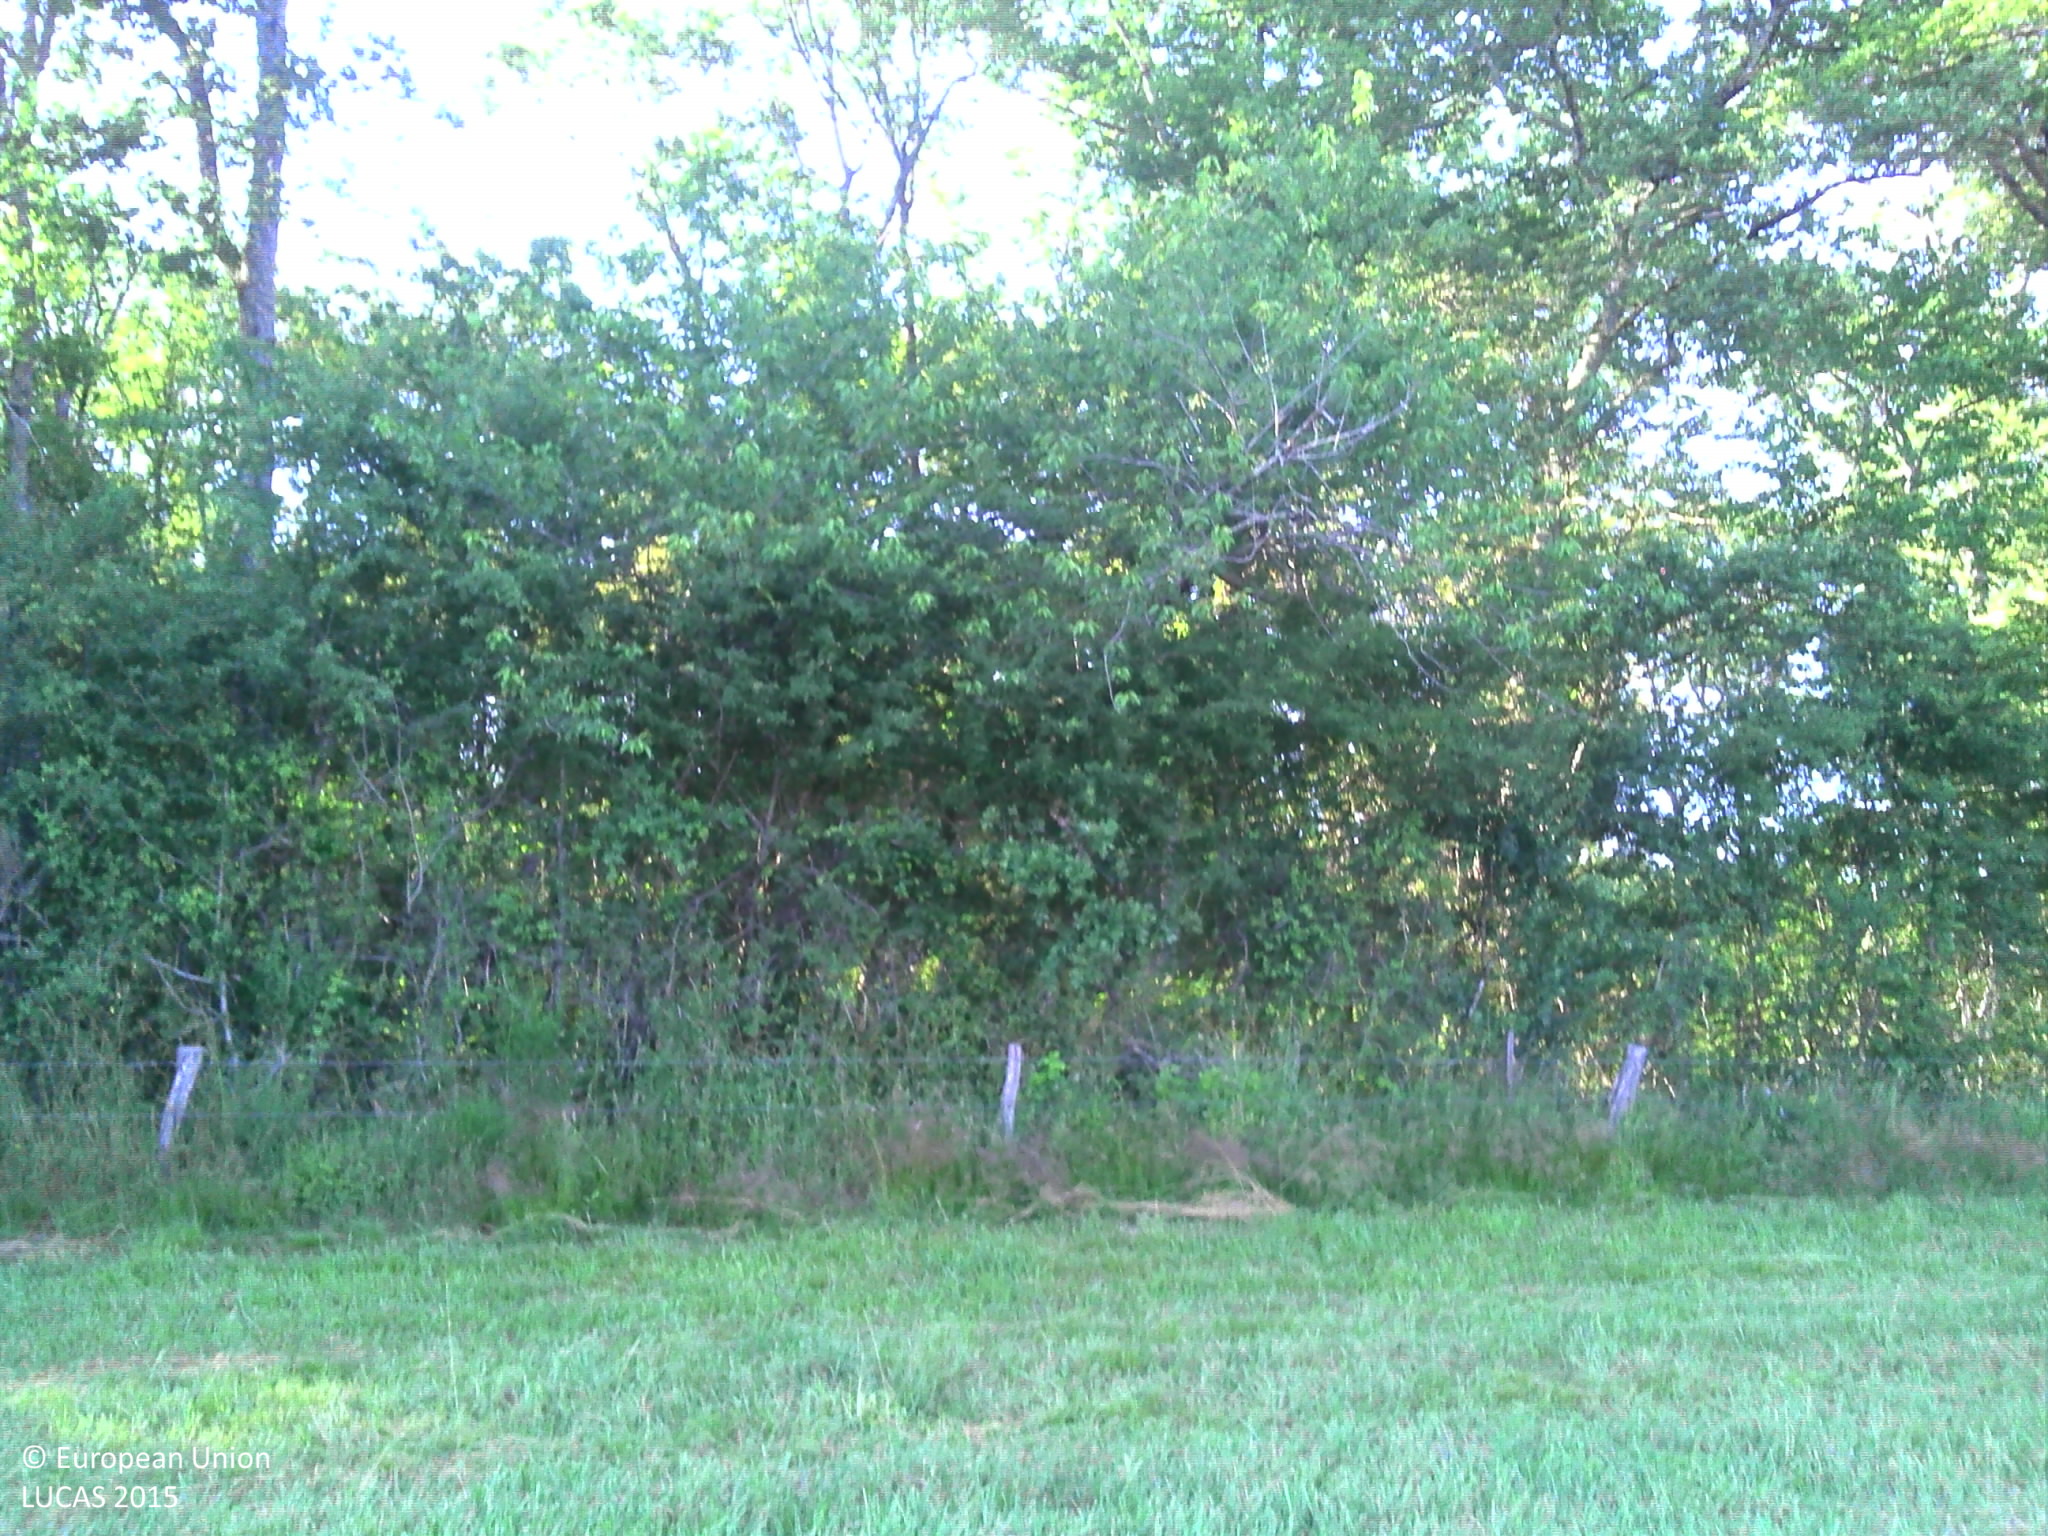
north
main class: Grassland
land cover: Grassland without tree/shrub cover
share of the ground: > 75 %
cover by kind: herbaceous plants 100 %
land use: Agriculture (excluding fallow land and kitchen gardens)
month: June
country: FR
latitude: 46.8434
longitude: 2.9806
